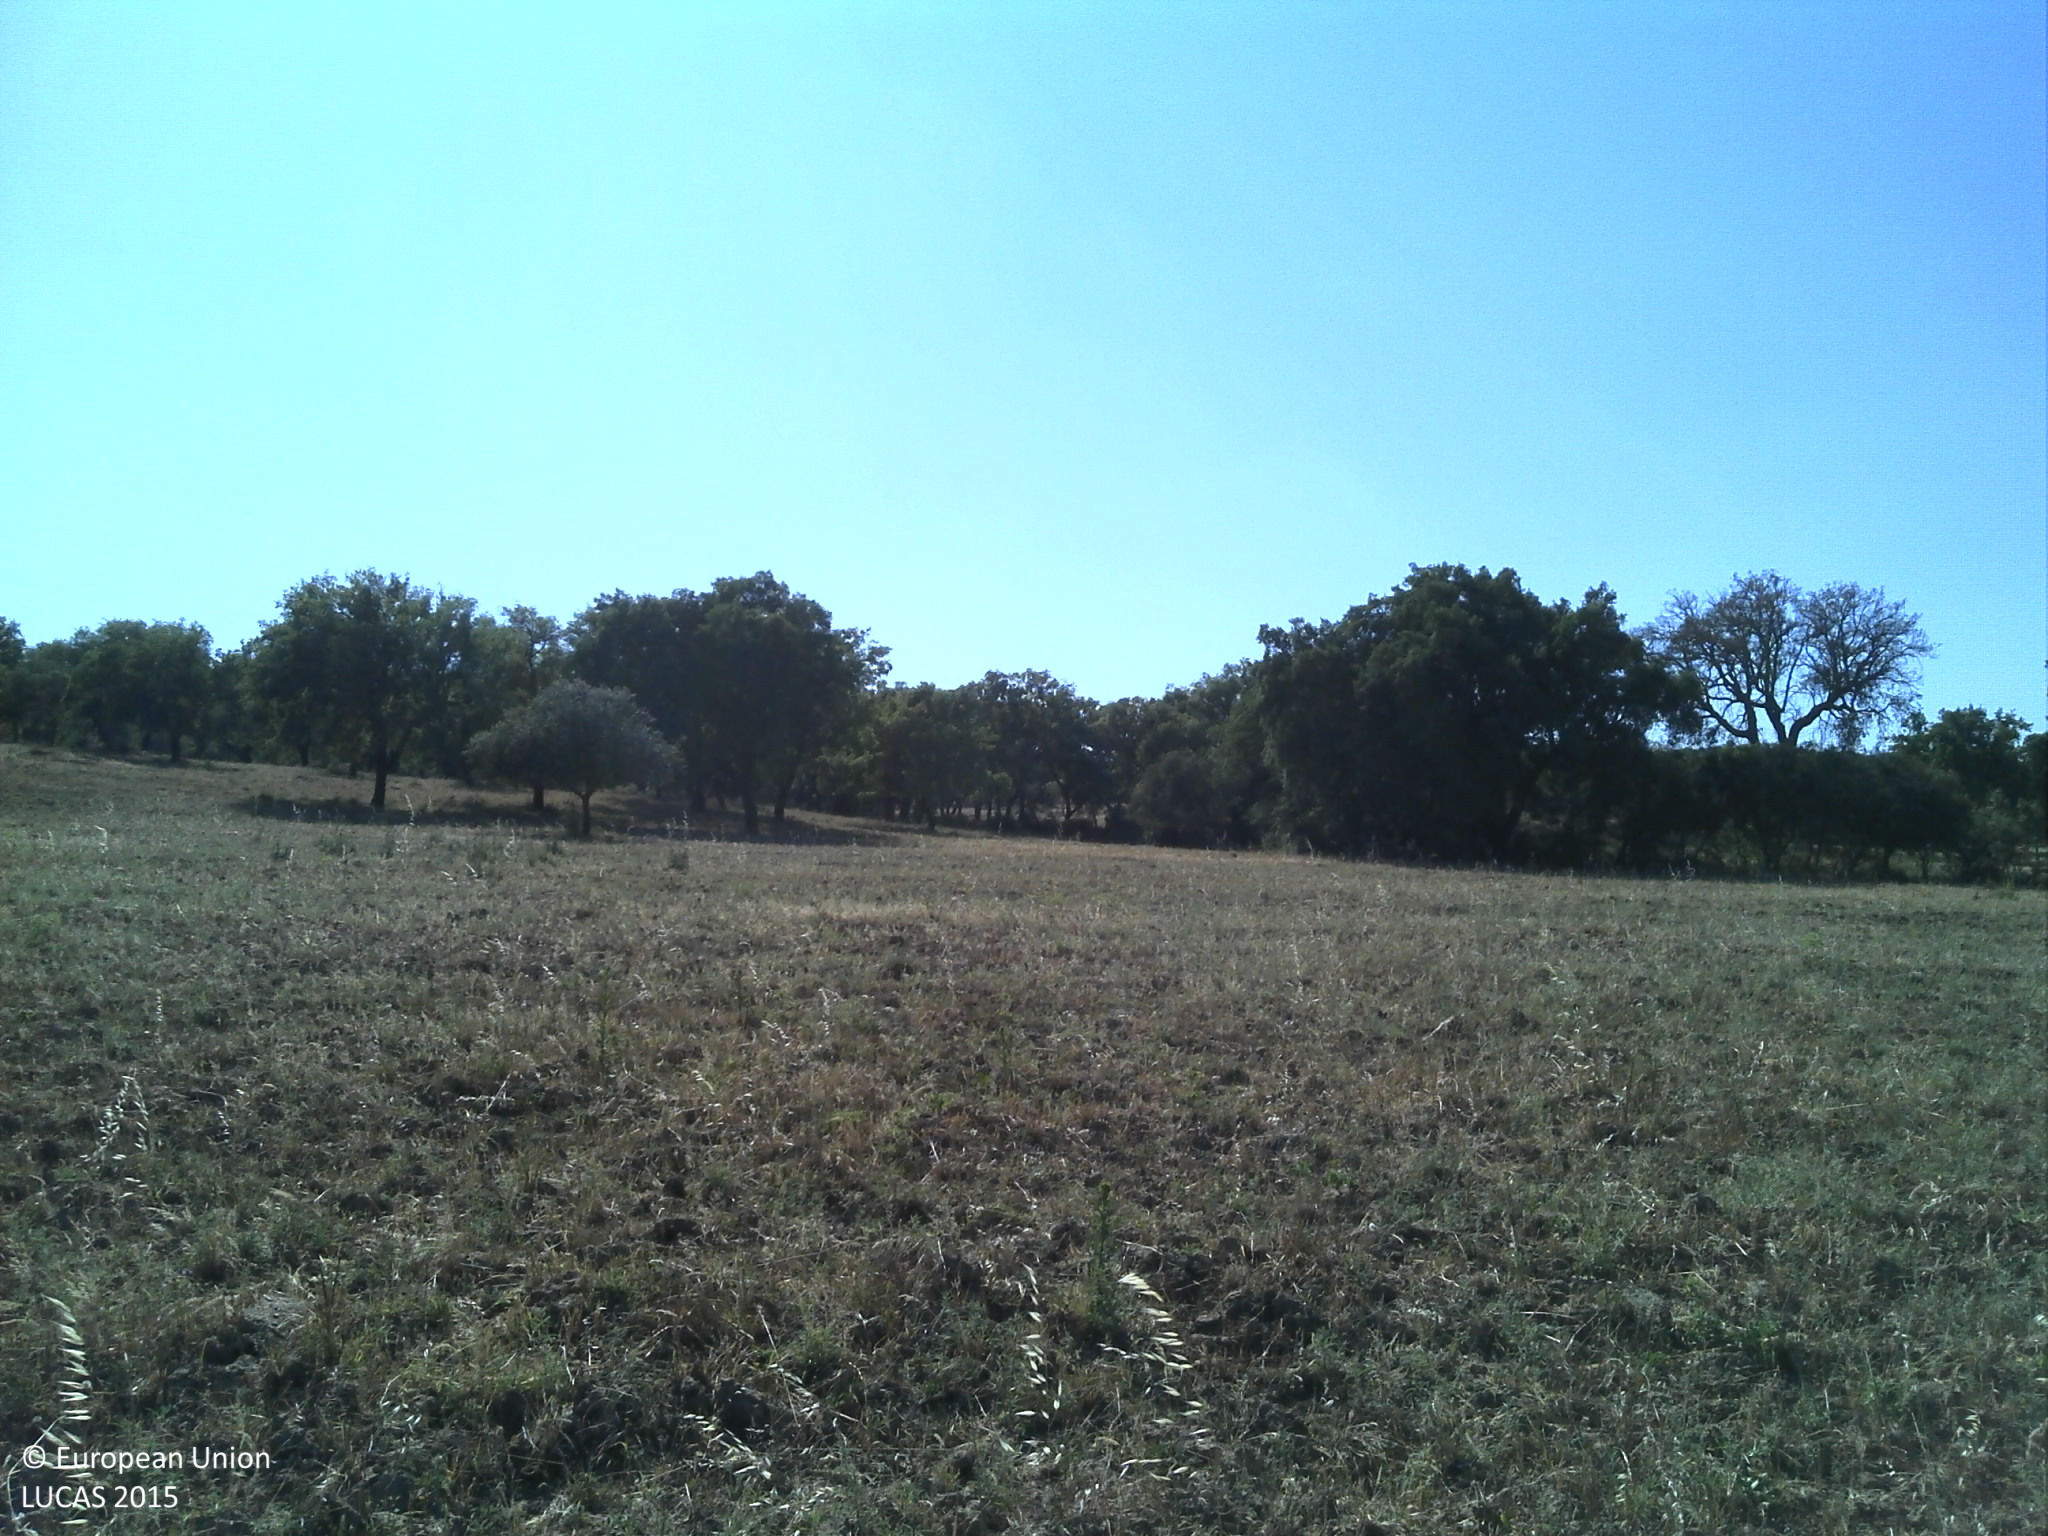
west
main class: Woodland
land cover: Broadleaved woodland
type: broadleaved evergreen forest
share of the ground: 10 - 25 %
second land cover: Grassland without tree/shrub cover
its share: 25 - 50 %
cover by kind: unconsolidated bare surface 55 %, herbaceous plants 25 %, broadleaved forest trees 20 %
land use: Forestry
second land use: Agriculture (excluding fallow land and kitchen gardens)
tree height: > 5 m
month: June
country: PT
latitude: 38.7088
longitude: -8.1368
